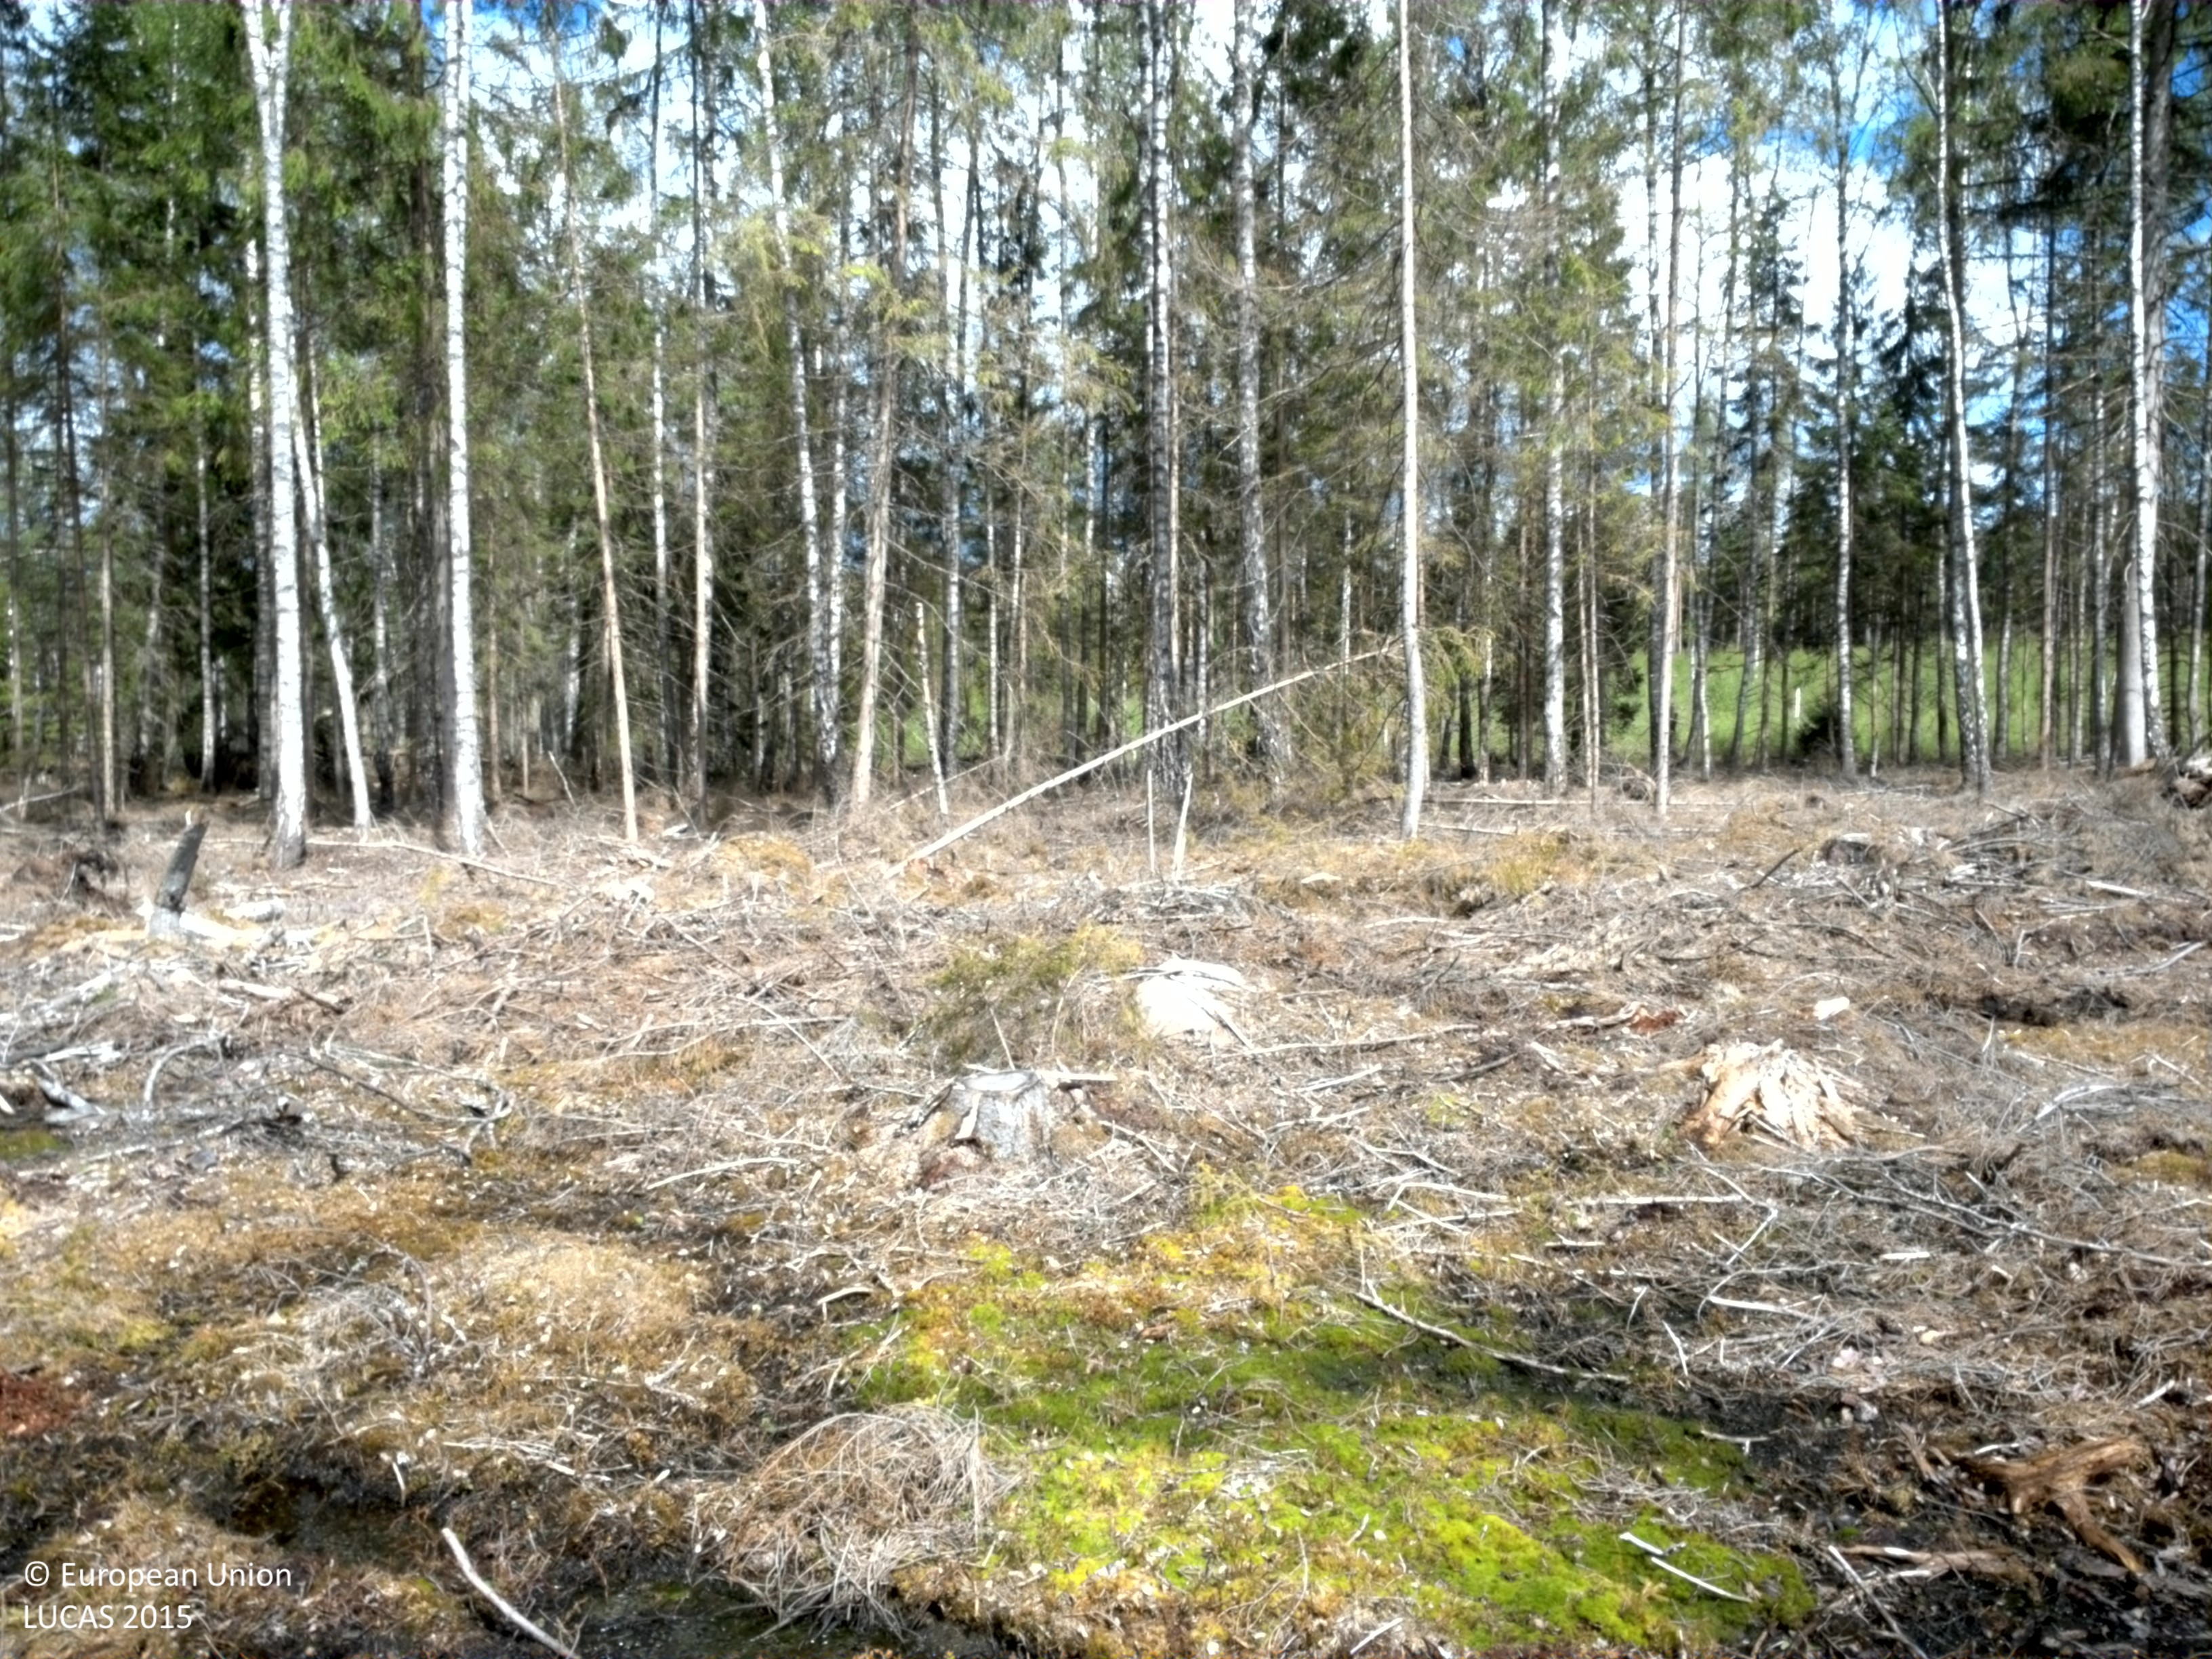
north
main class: Shrubland
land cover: Shrubland with sparse tree cover
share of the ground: 10 - 25 %
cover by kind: herbaceous plants 25 %, lichens and mosses 20 %, shrubs 10 %, coniferous forest trees 5 %
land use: Forestry
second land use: Amenities, museums, leisure
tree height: < 5 m
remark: Clear cut
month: May
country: SE
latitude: 56.9466
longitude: 14.7478
